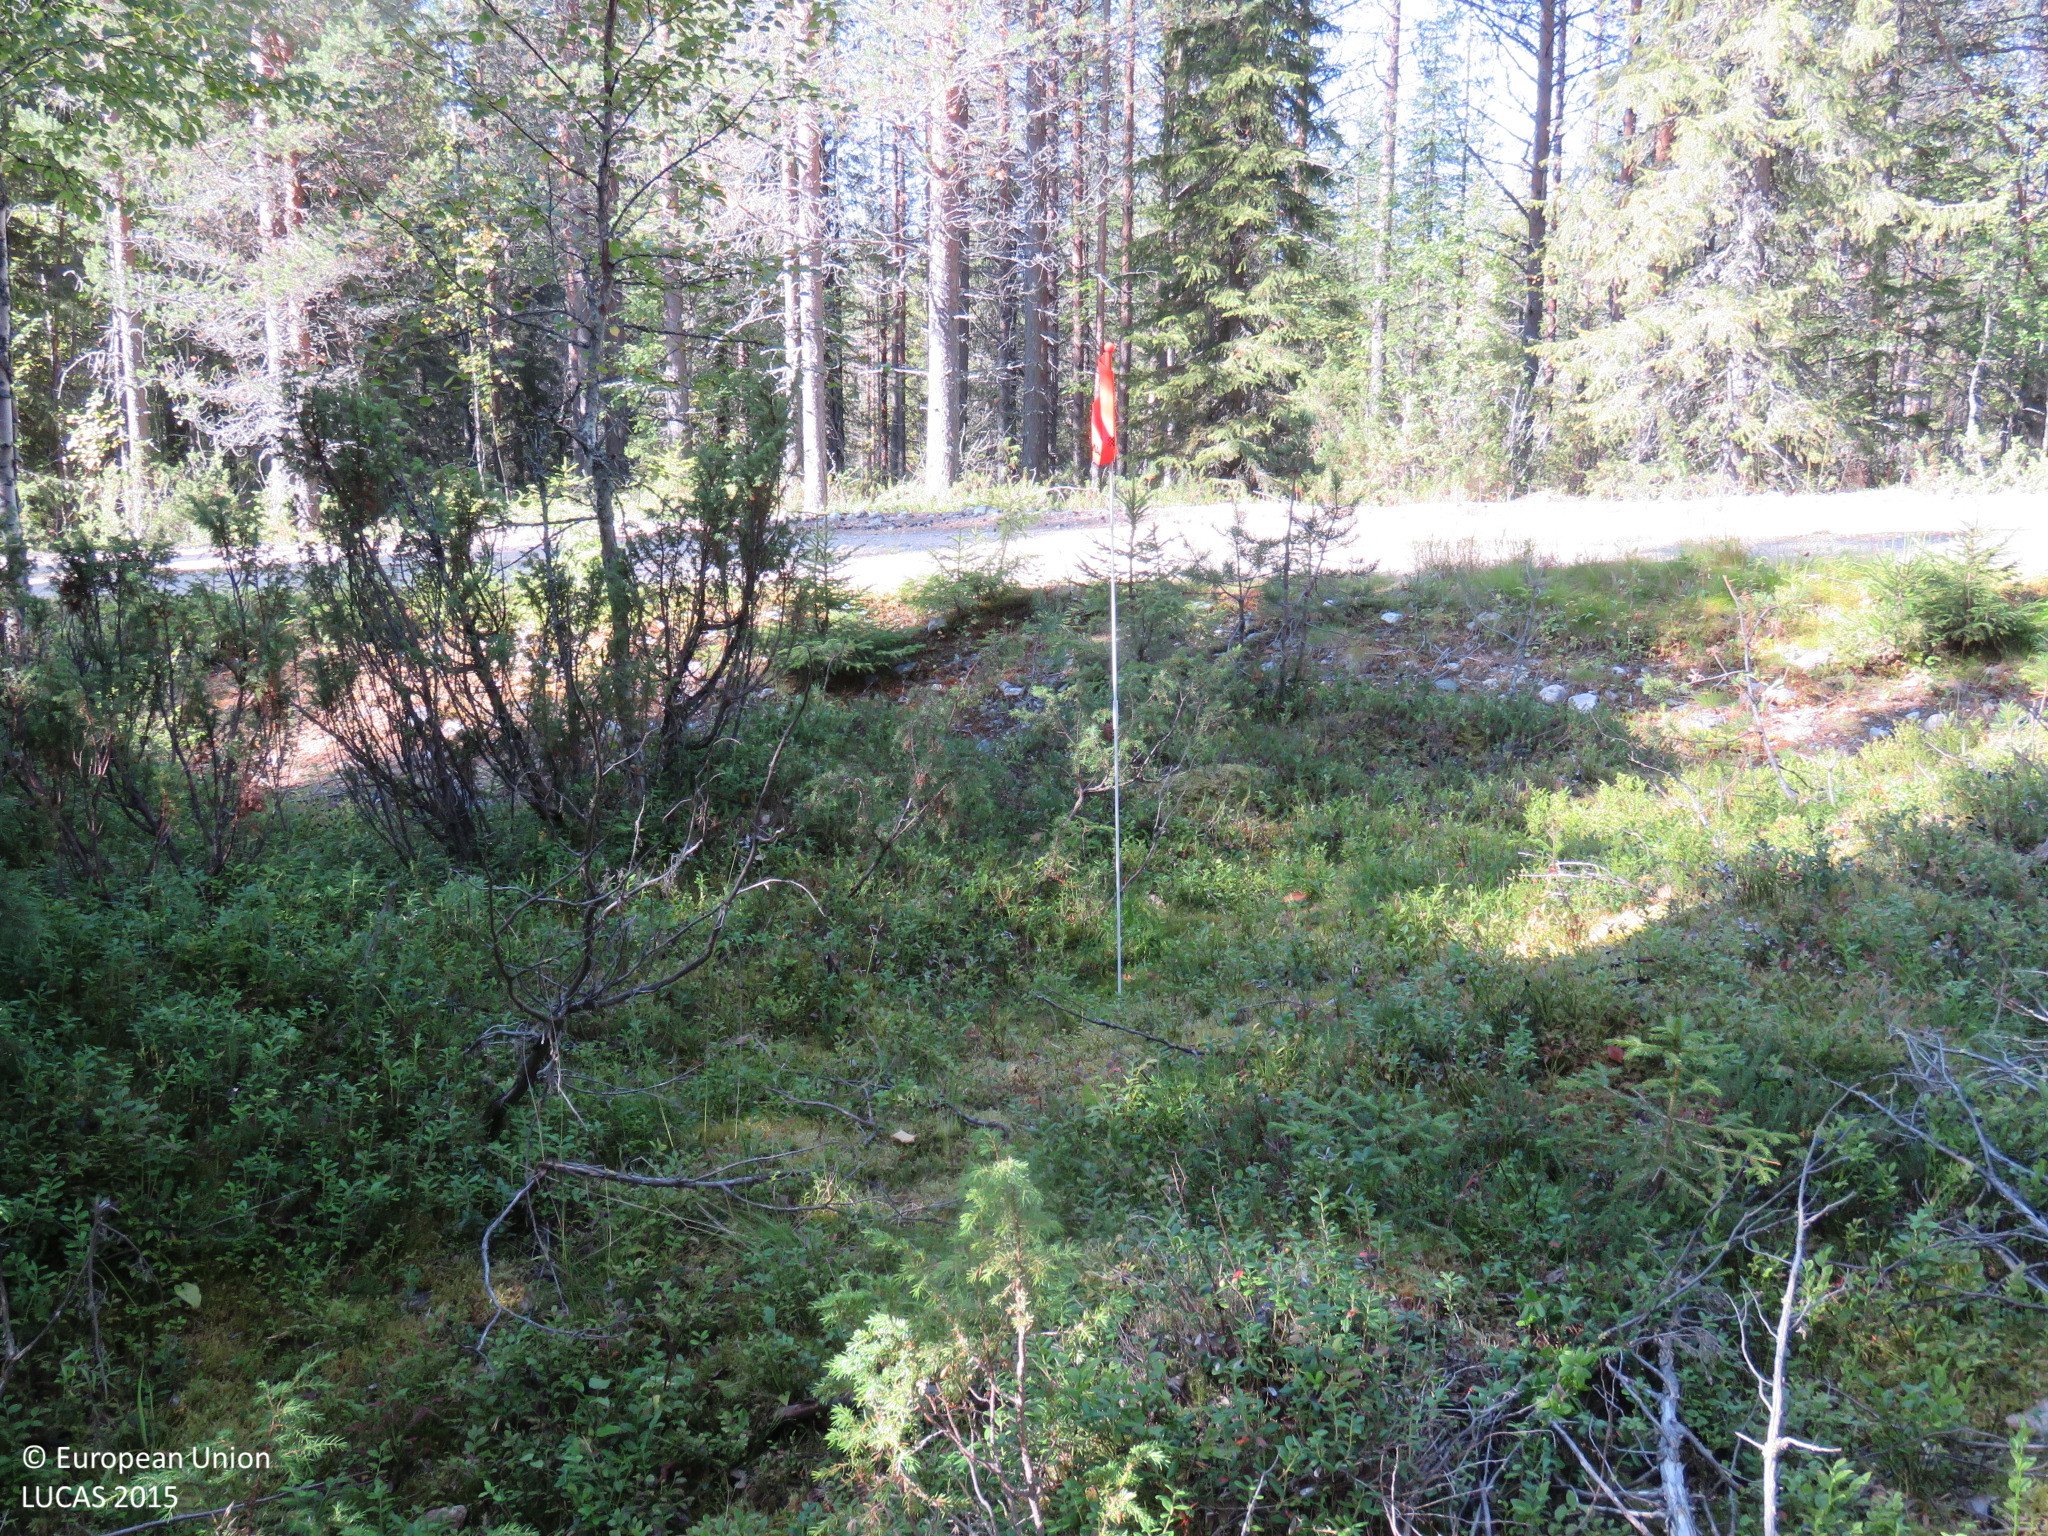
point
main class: Woodland
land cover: Other coniferous woodland
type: boreal forest
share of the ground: > 75 %
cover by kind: coniferous forest trees 60 %, shrubs 20 %, broadleaved forest trees 15 %, lichens and mosses 5 %
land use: Forestry
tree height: > 5 m
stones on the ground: < 10 %
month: September
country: FI
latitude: 65.5395
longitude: 27.6430
